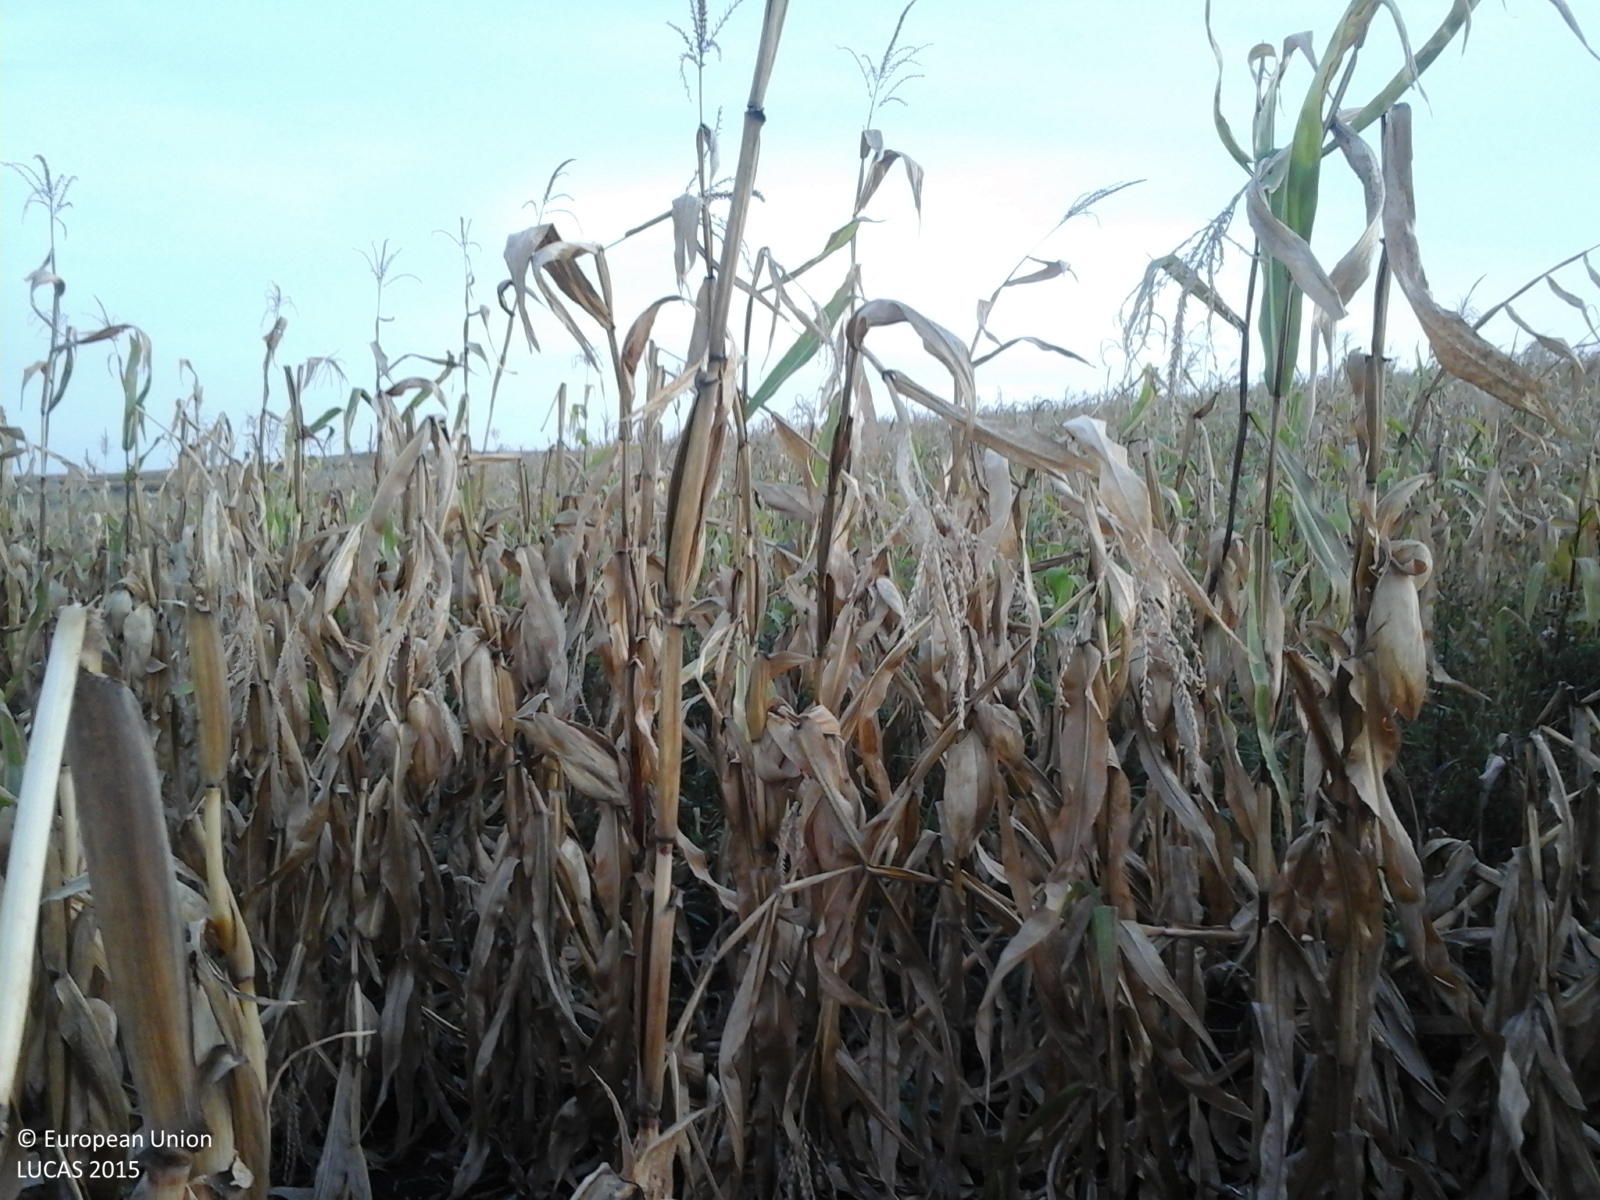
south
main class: Cropland
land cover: Maize
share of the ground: > 75 %
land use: Agriculture (excluding fallow land and kitchen gardens)
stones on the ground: < 10 %
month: September
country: RO
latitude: 46.5439
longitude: 23.9649
